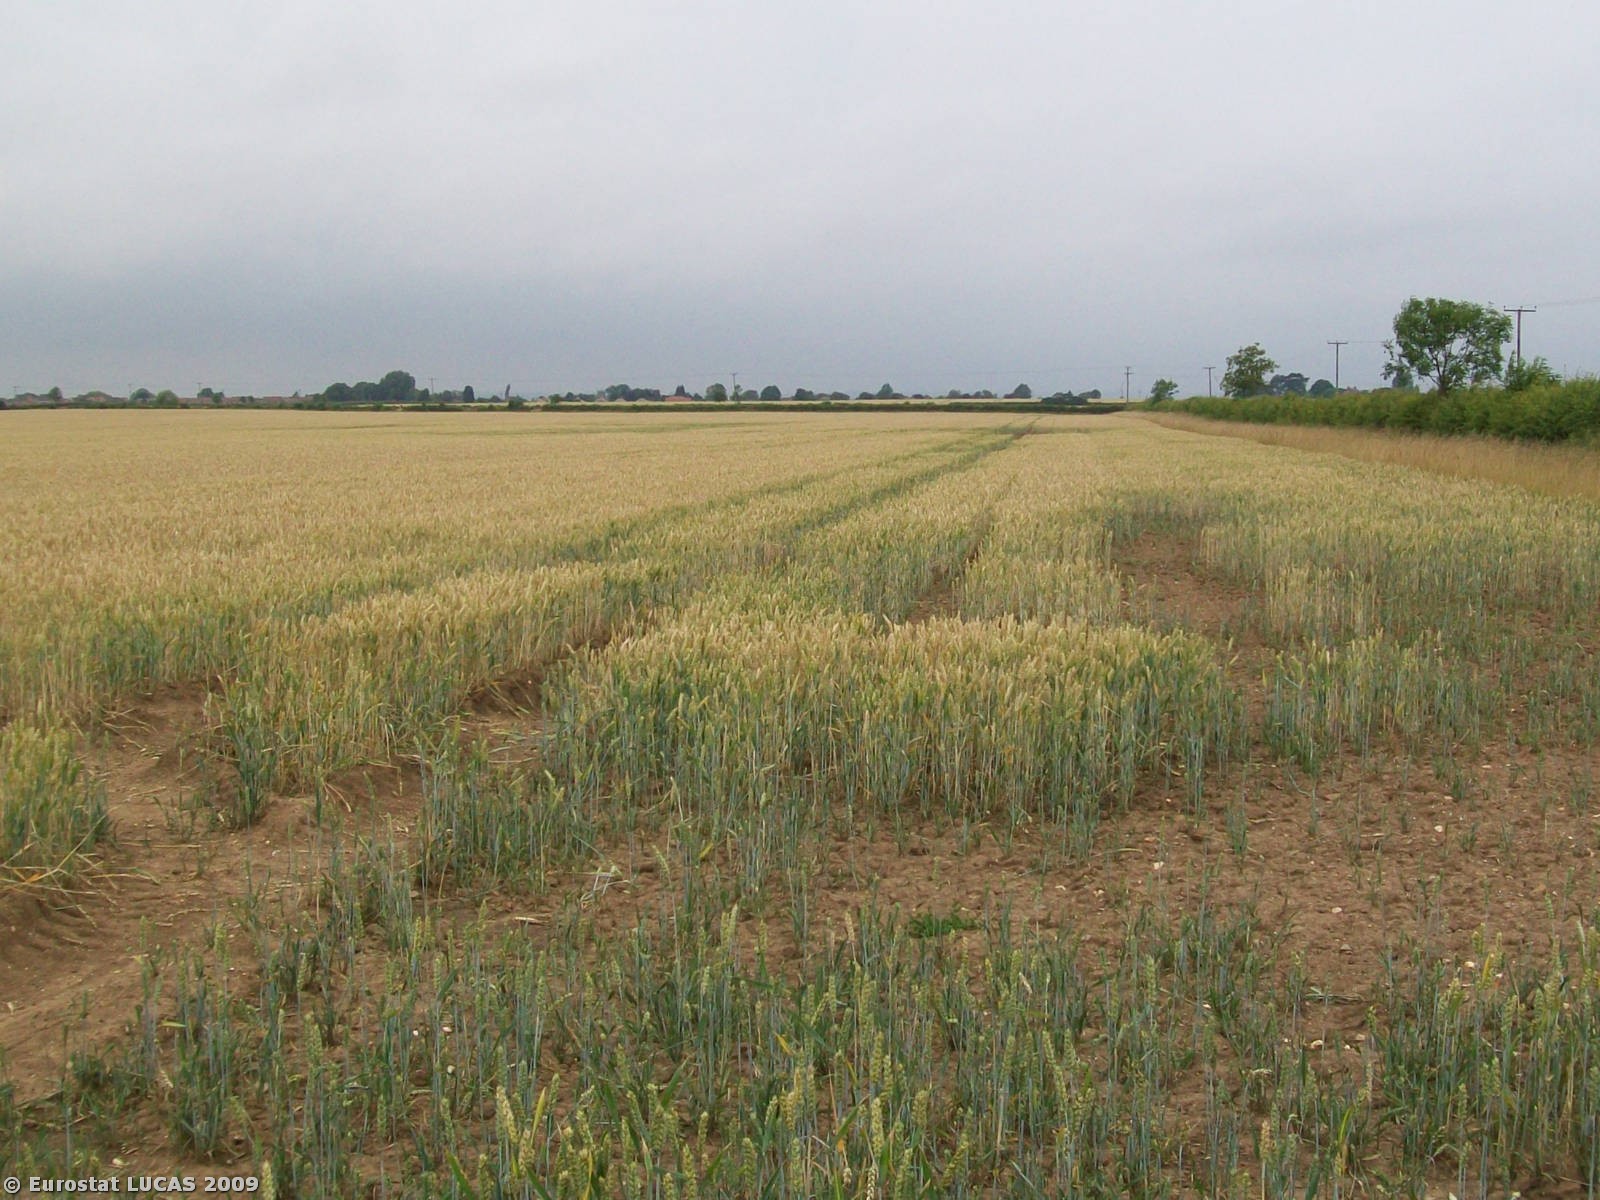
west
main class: Cropland
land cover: Common wheat
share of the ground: > 75 %
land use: Agriculture (excluding fallow land and kitchen gardens)
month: July
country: GB
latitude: 53.8706
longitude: -0.2694
